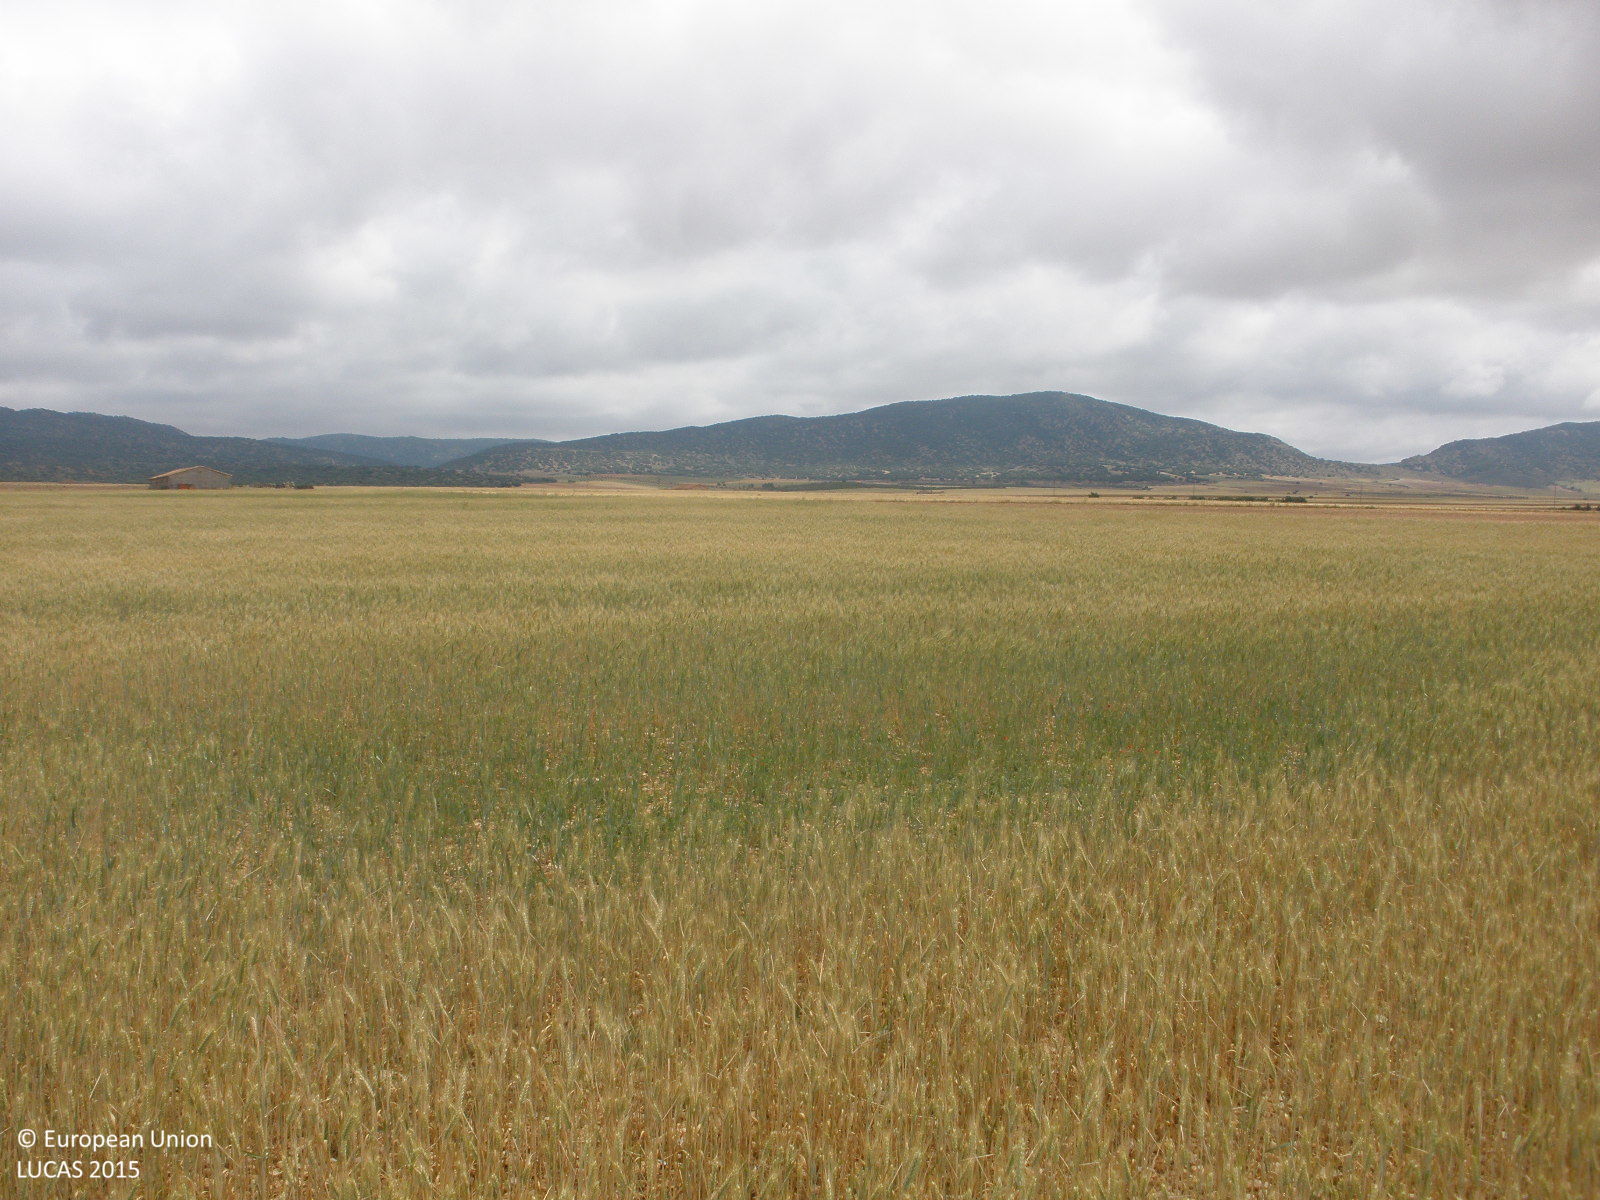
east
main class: Cropland
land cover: Common wheat
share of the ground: > 75 %
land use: Agriculture (excluding fallow land and kitchen gardens)
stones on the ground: > 50 %
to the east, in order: Common wheat; Grass margins; Common wheat; Tracks; Other bare soil; Grass margins; Barley
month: June
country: ES
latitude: 40.6361
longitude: -1.2829
